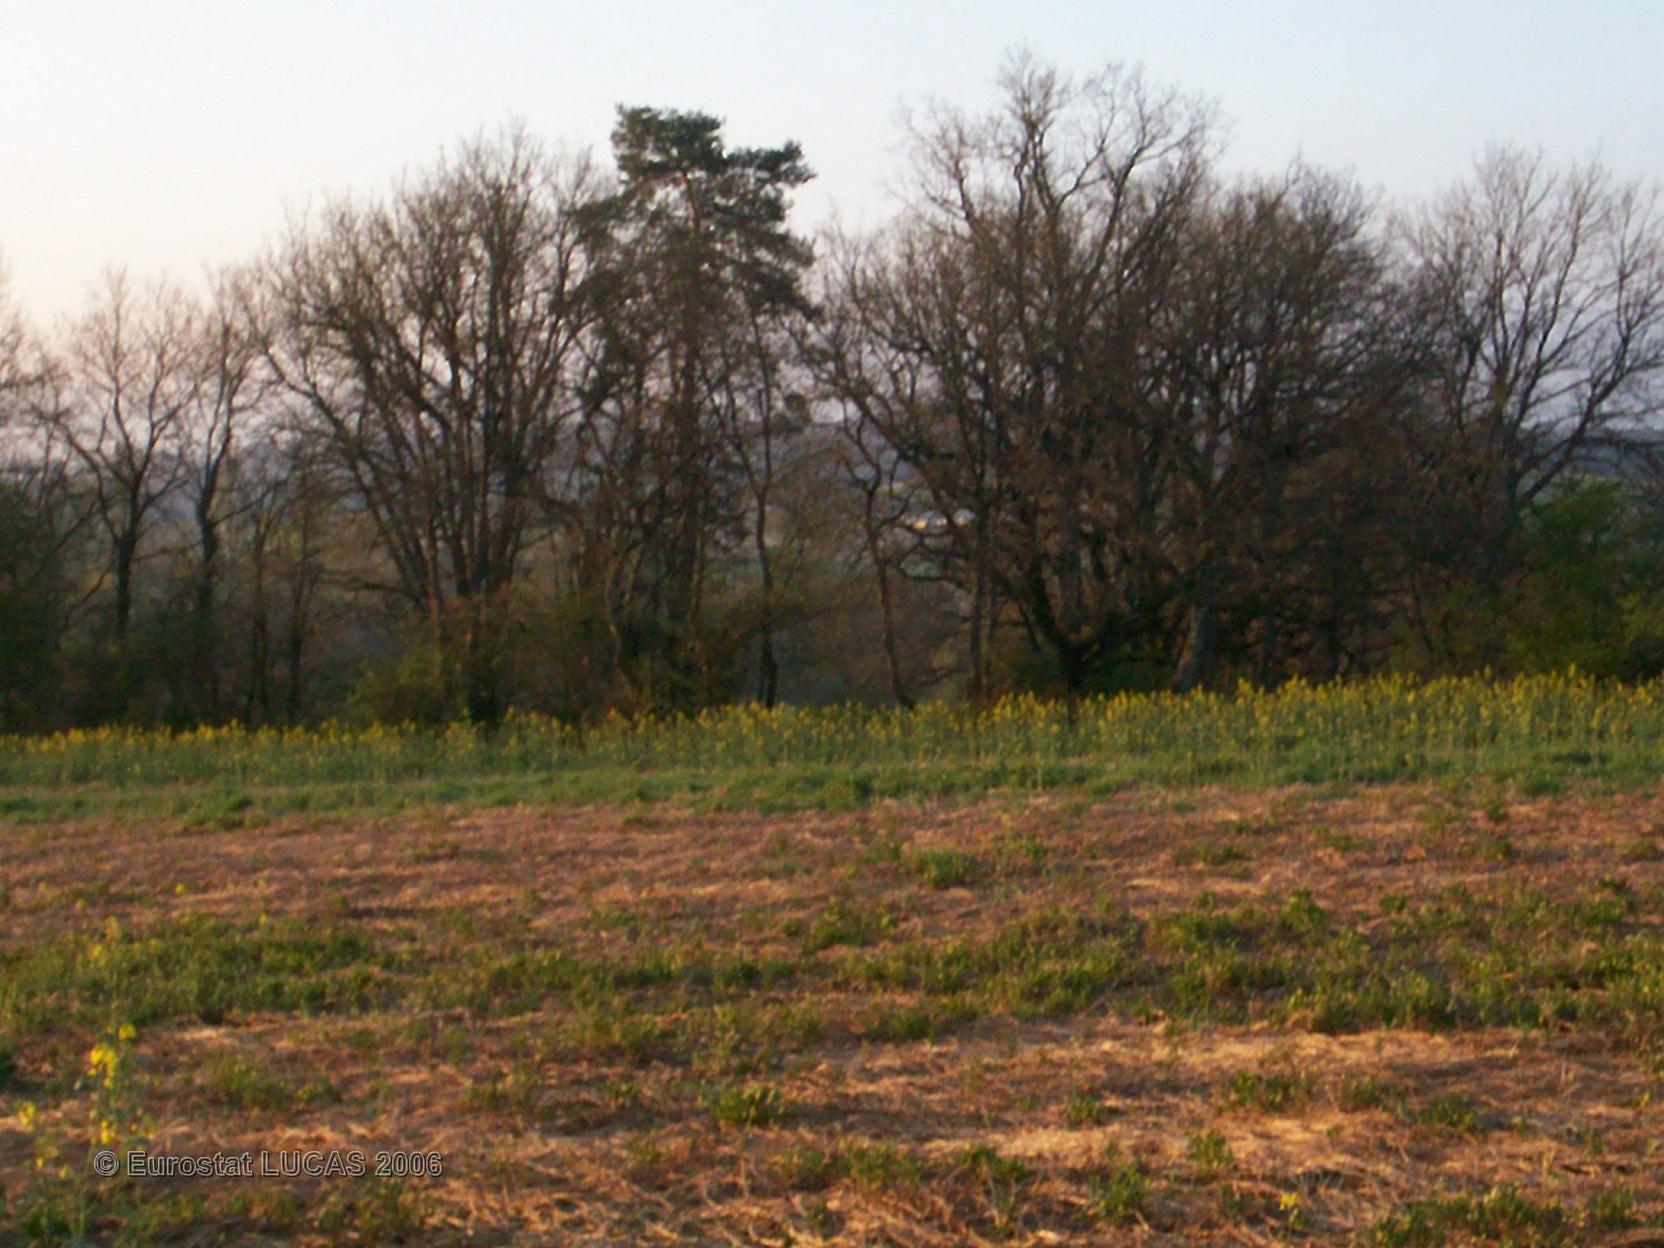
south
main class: Cropland
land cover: Rape and turnip rape
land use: Agriculture (excluding fallow land and kitchen gardens)
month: April
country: FR
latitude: 43.5078
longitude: 0.2371
